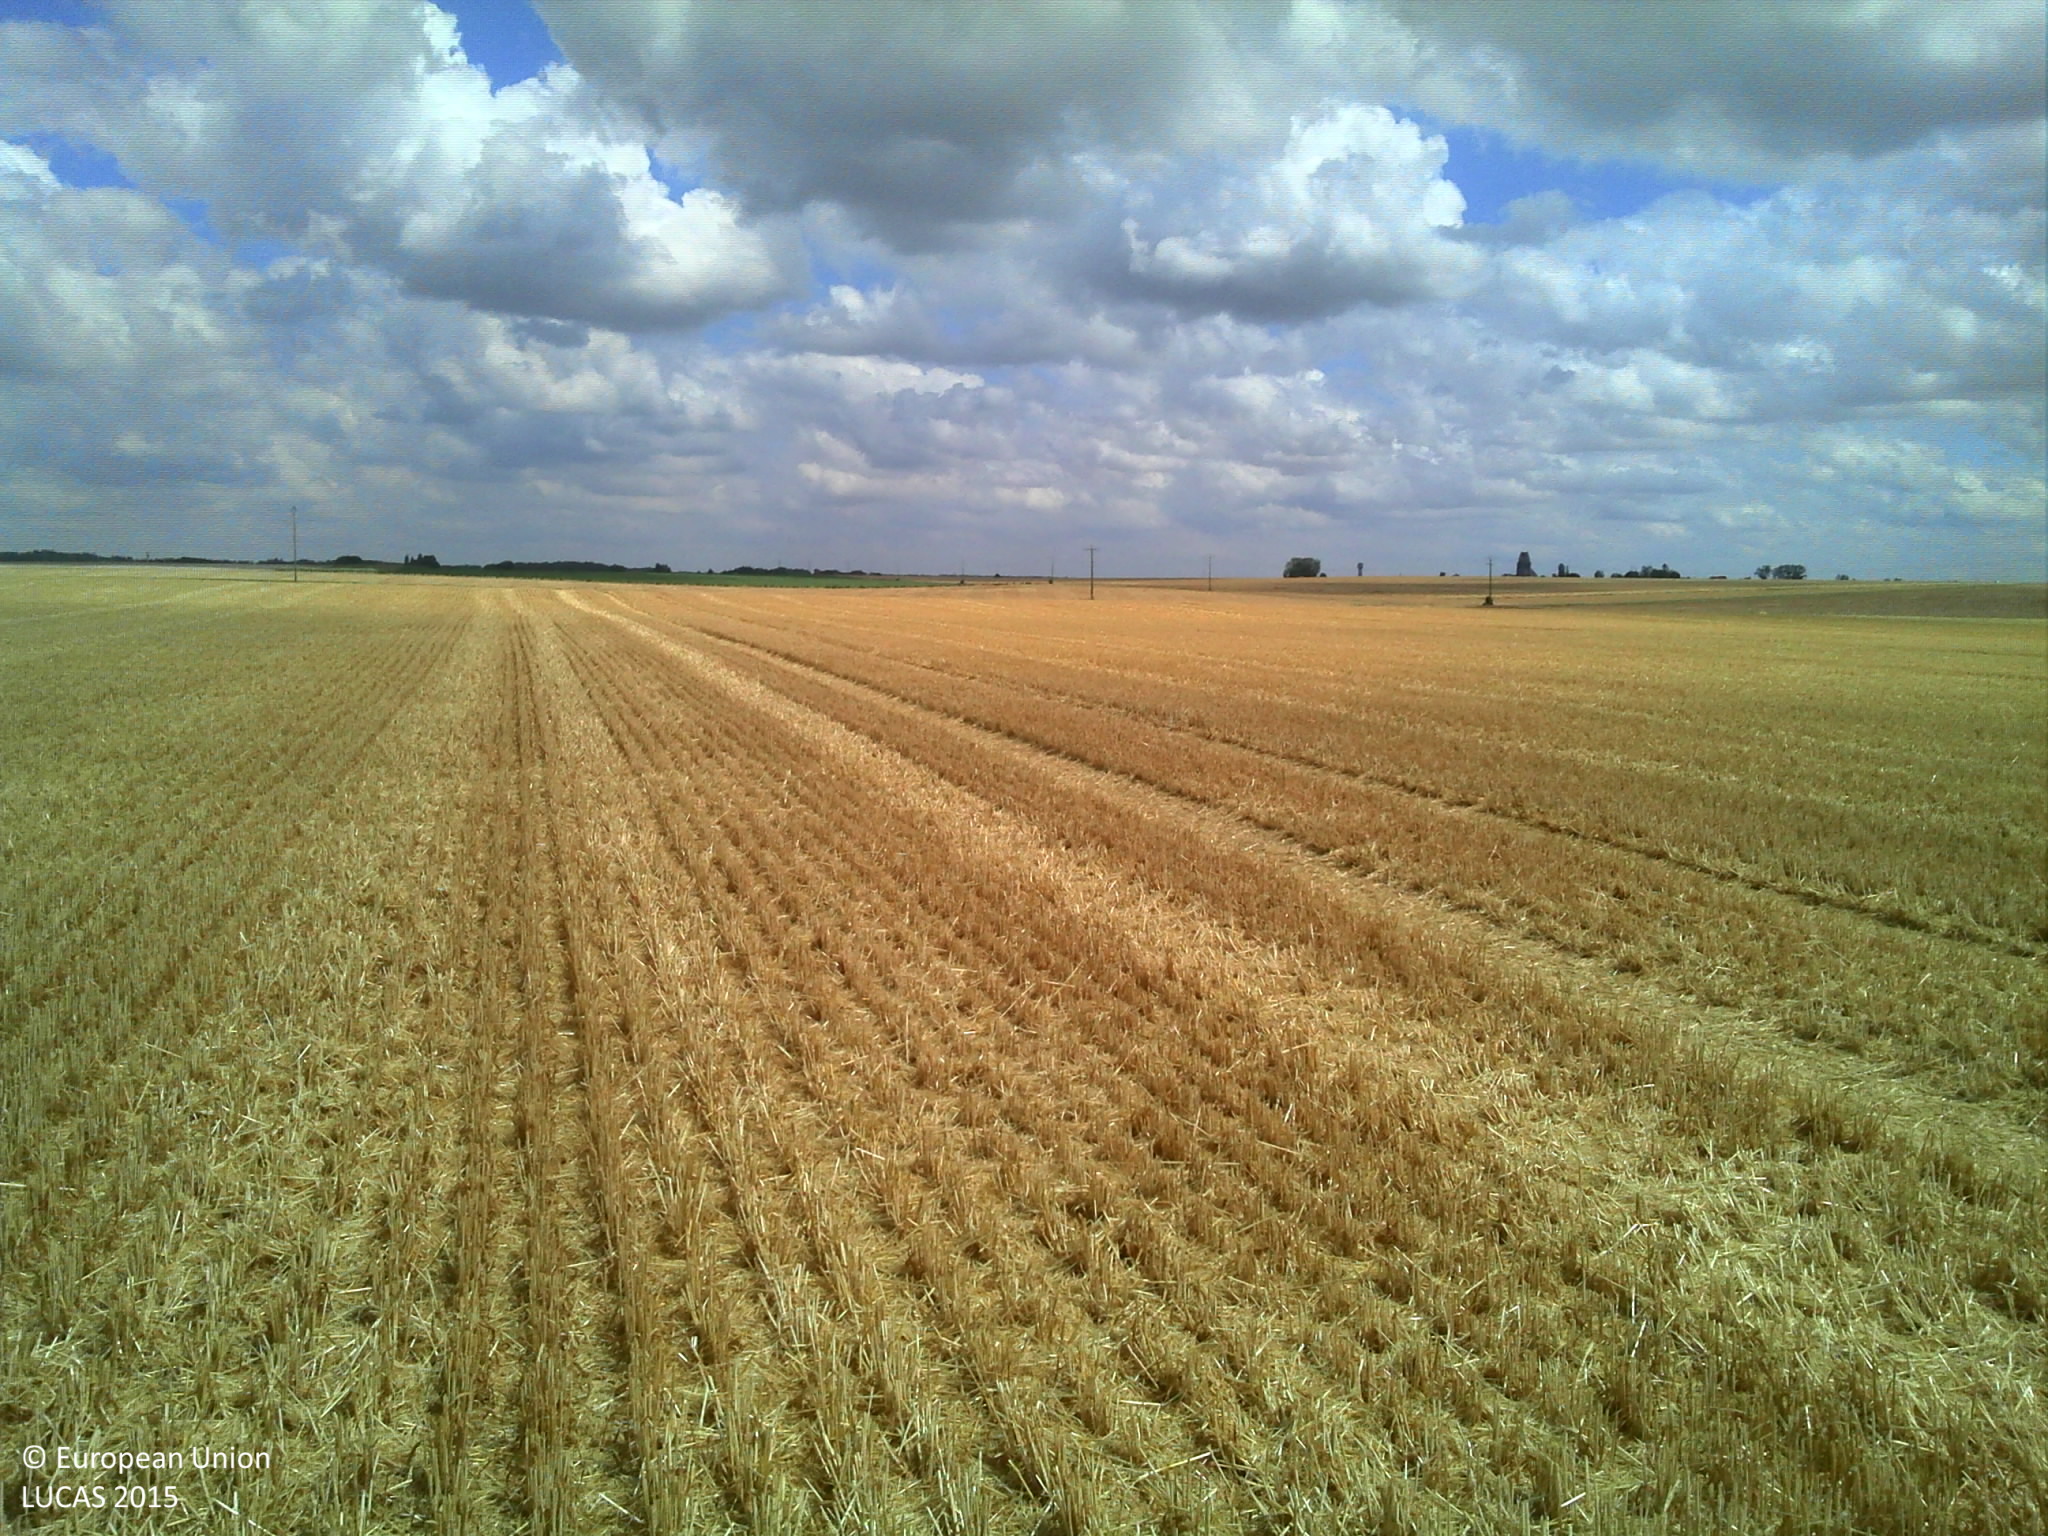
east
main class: Cropland
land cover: Barley
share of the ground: > 75 %
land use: Agriculture (excluding fallow land and kitchen gardens)
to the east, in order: Barley
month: August
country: FR
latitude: 48.6059
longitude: 3.4431
